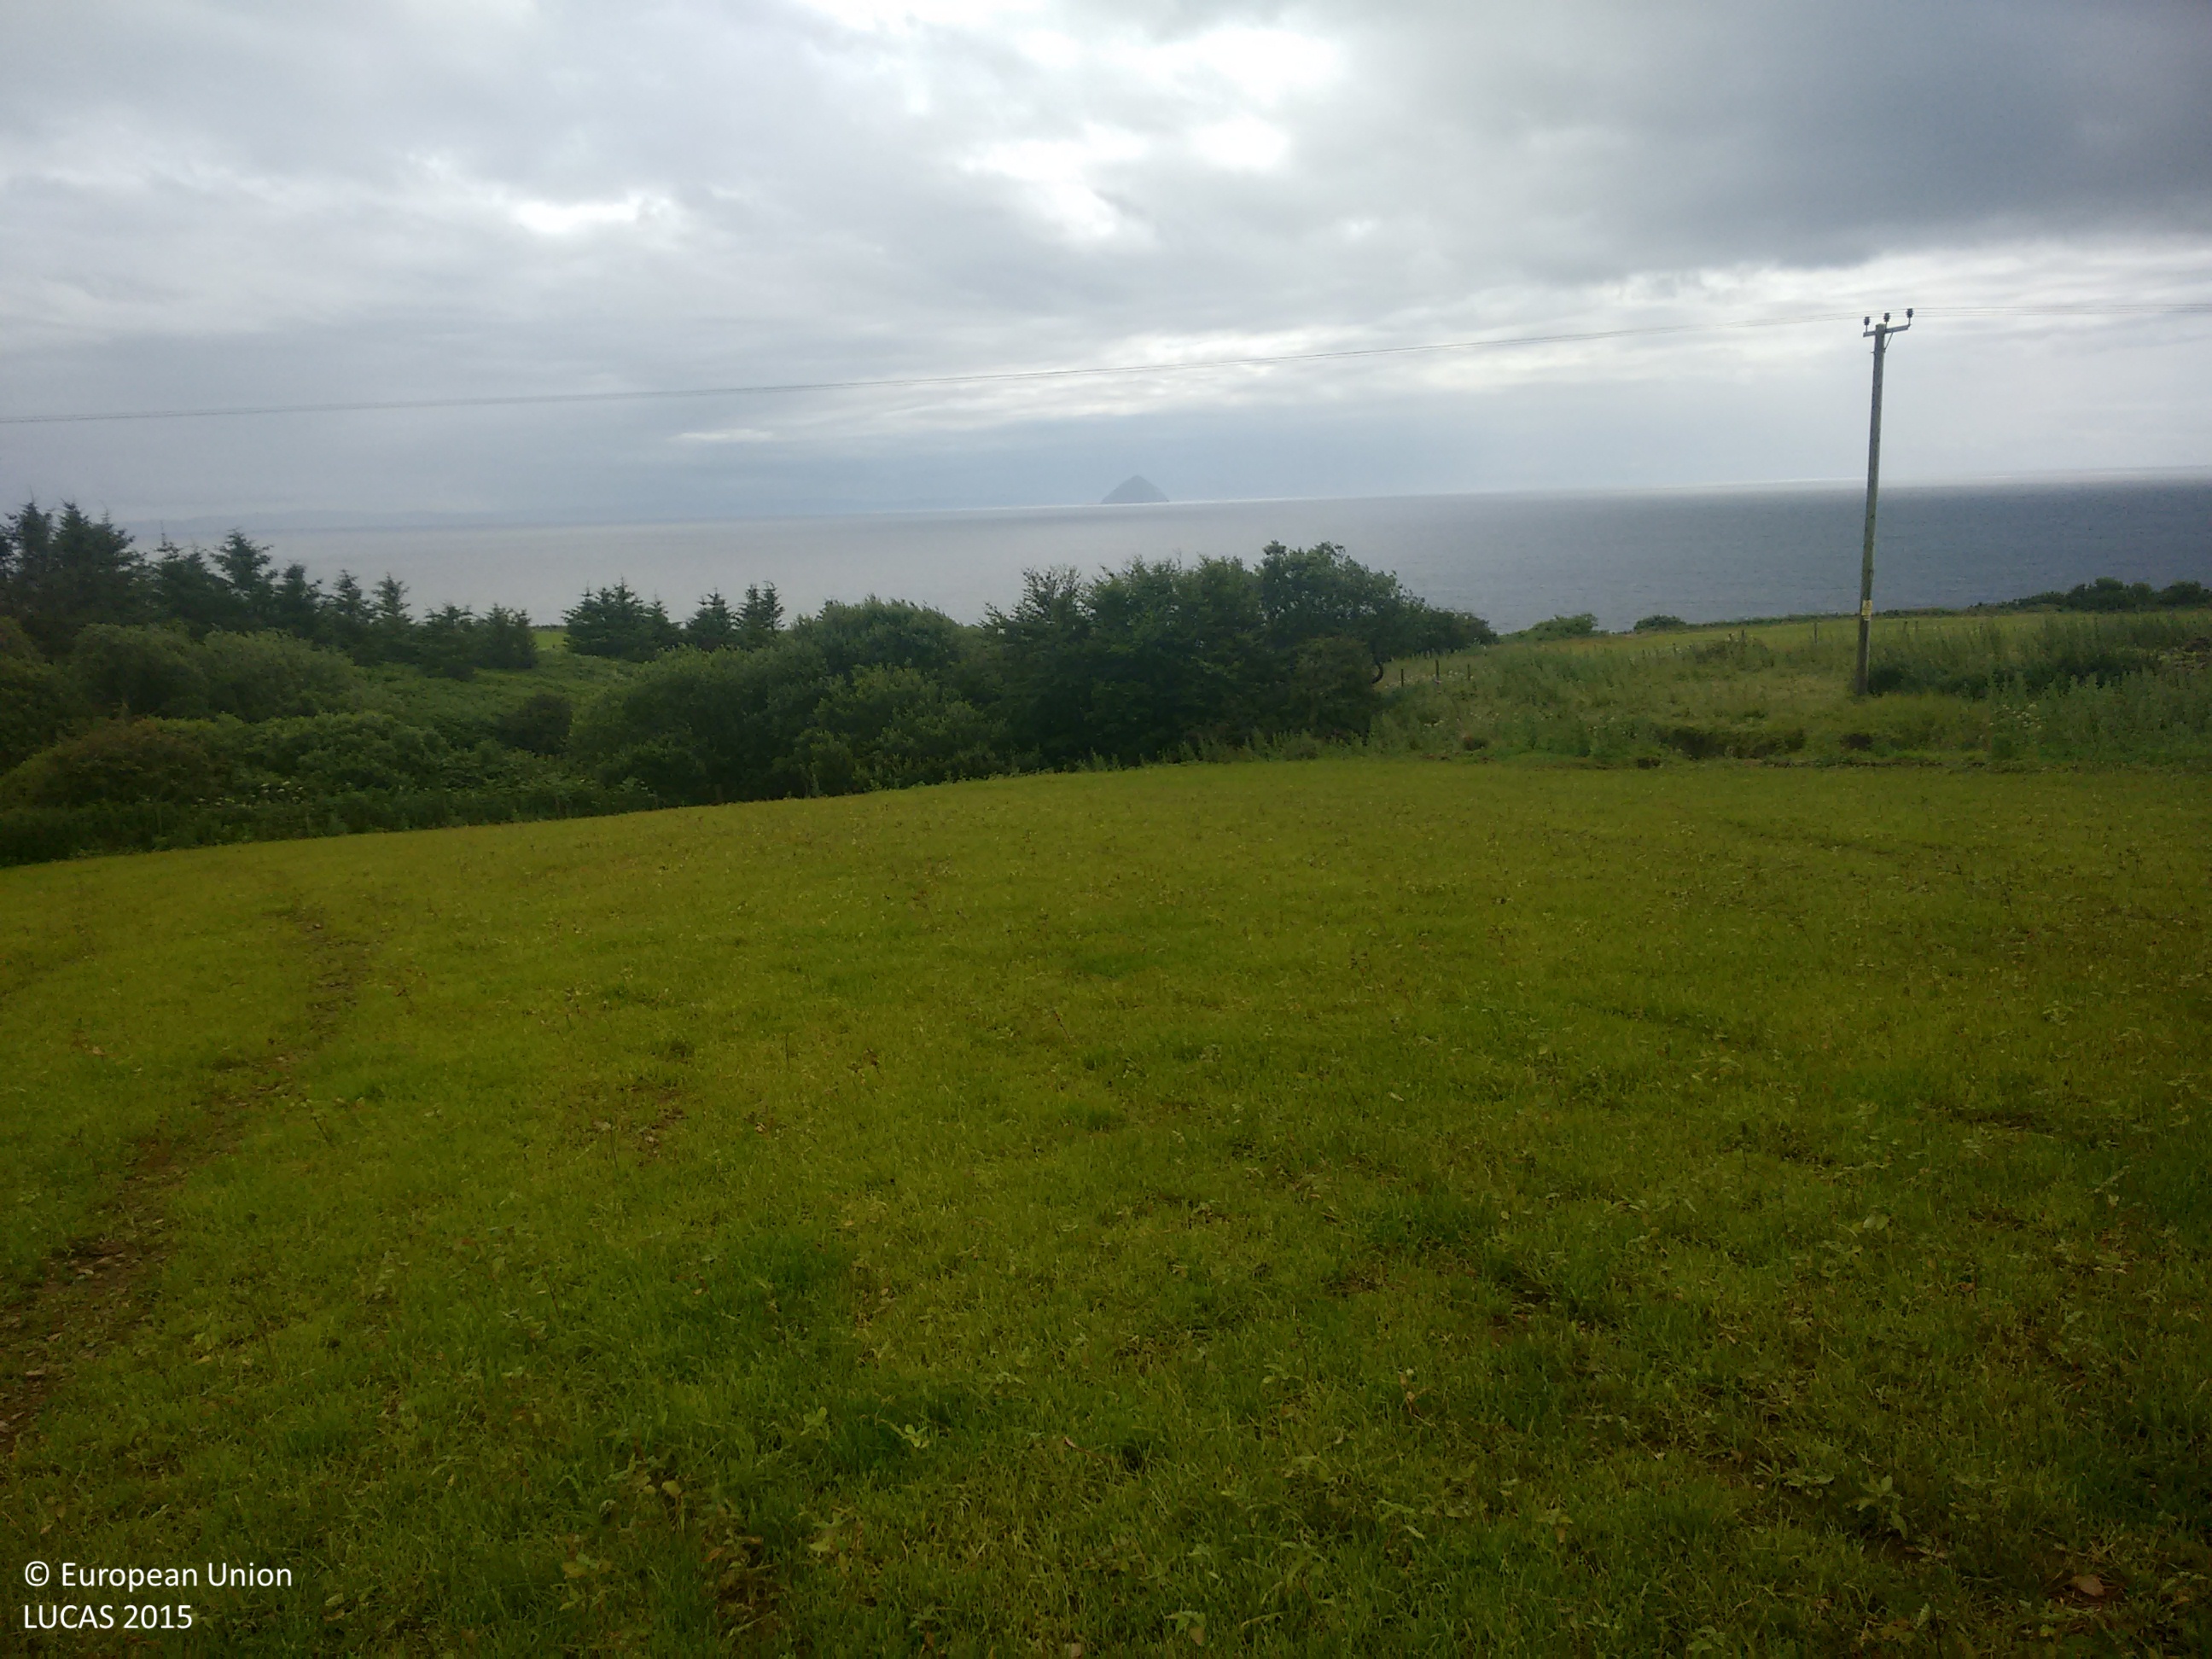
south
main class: Grassland
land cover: Grassland without tree/shrub cover
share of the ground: > 75 %
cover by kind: herbaceous plants 100 %
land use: Agriculture (excluding fallow land and kitchen gardens)
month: July
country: GB
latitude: 55.4456
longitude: -5.1499
